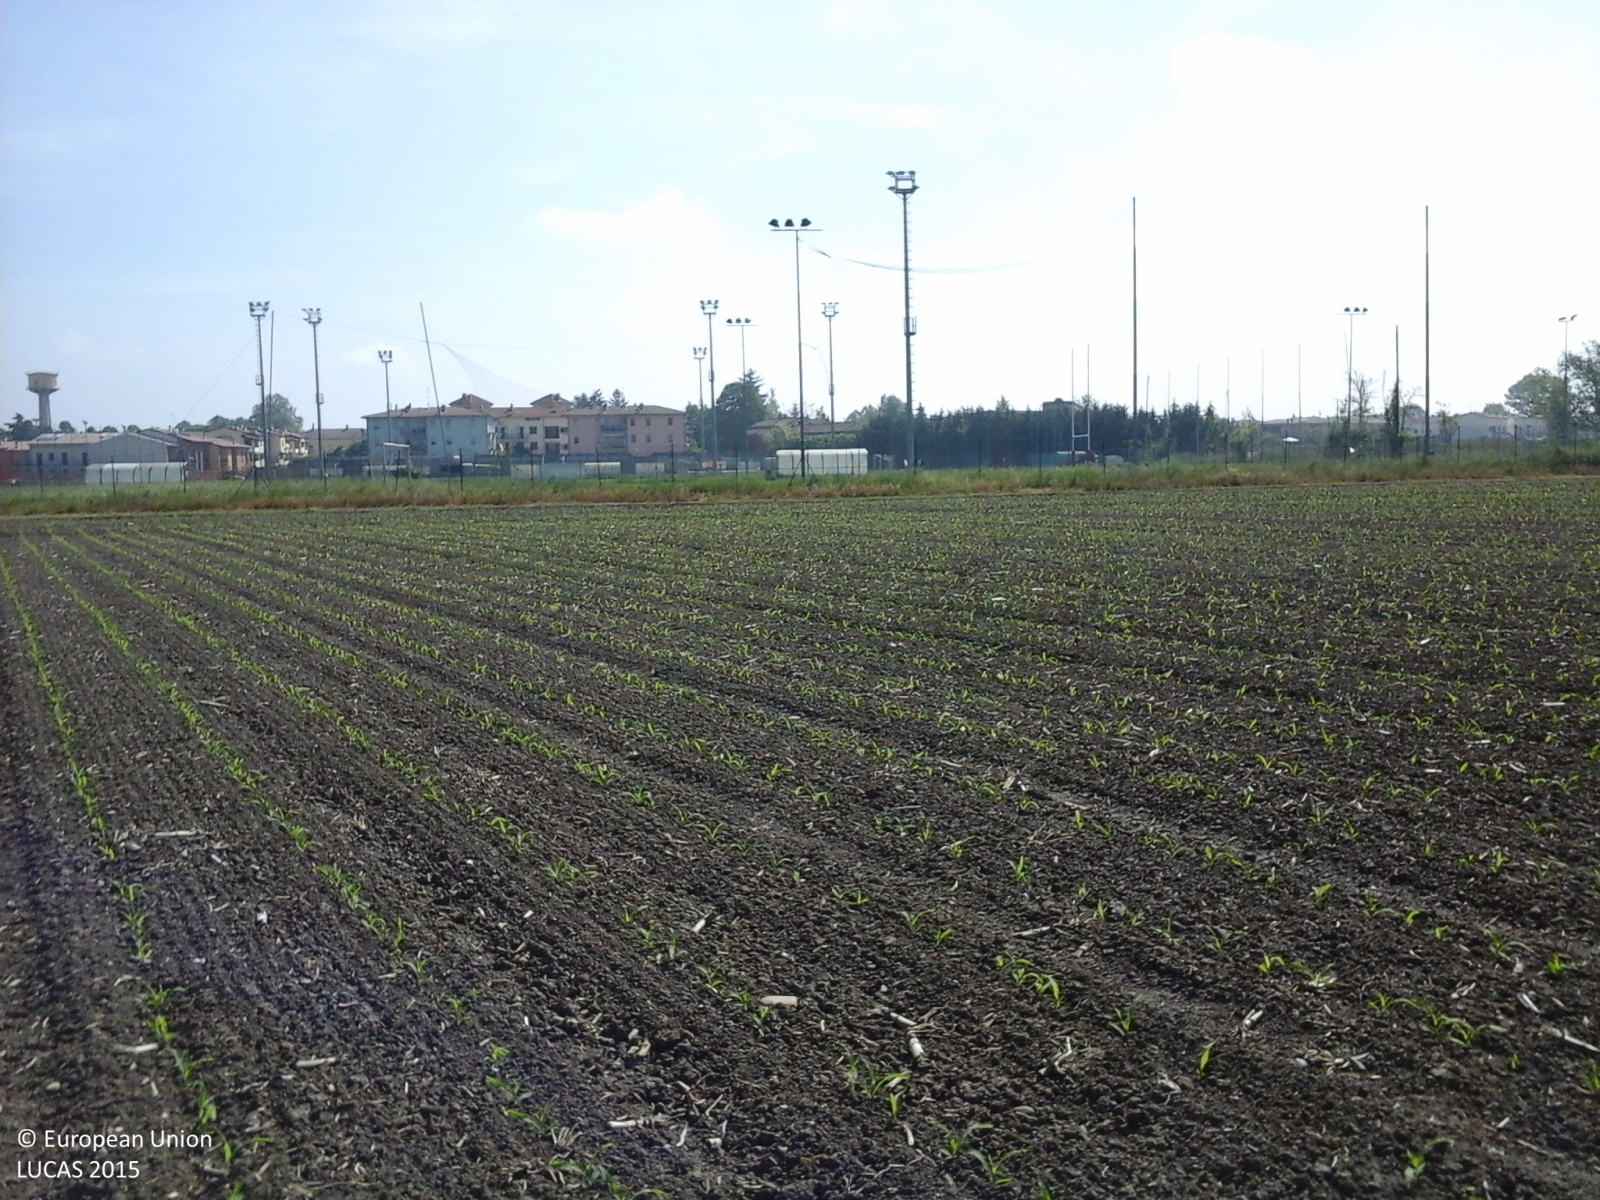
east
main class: Cropland
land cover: Maize
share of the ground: < 10 %
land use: Agriculture (excluding fallow land and kitchen gardens)
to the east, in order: Maize; Tracks; Ditches and canals; Grass margins; Fences; Artificial constructions in urban areas
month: May
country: IT
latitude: 44.9990
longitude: 9.6075
